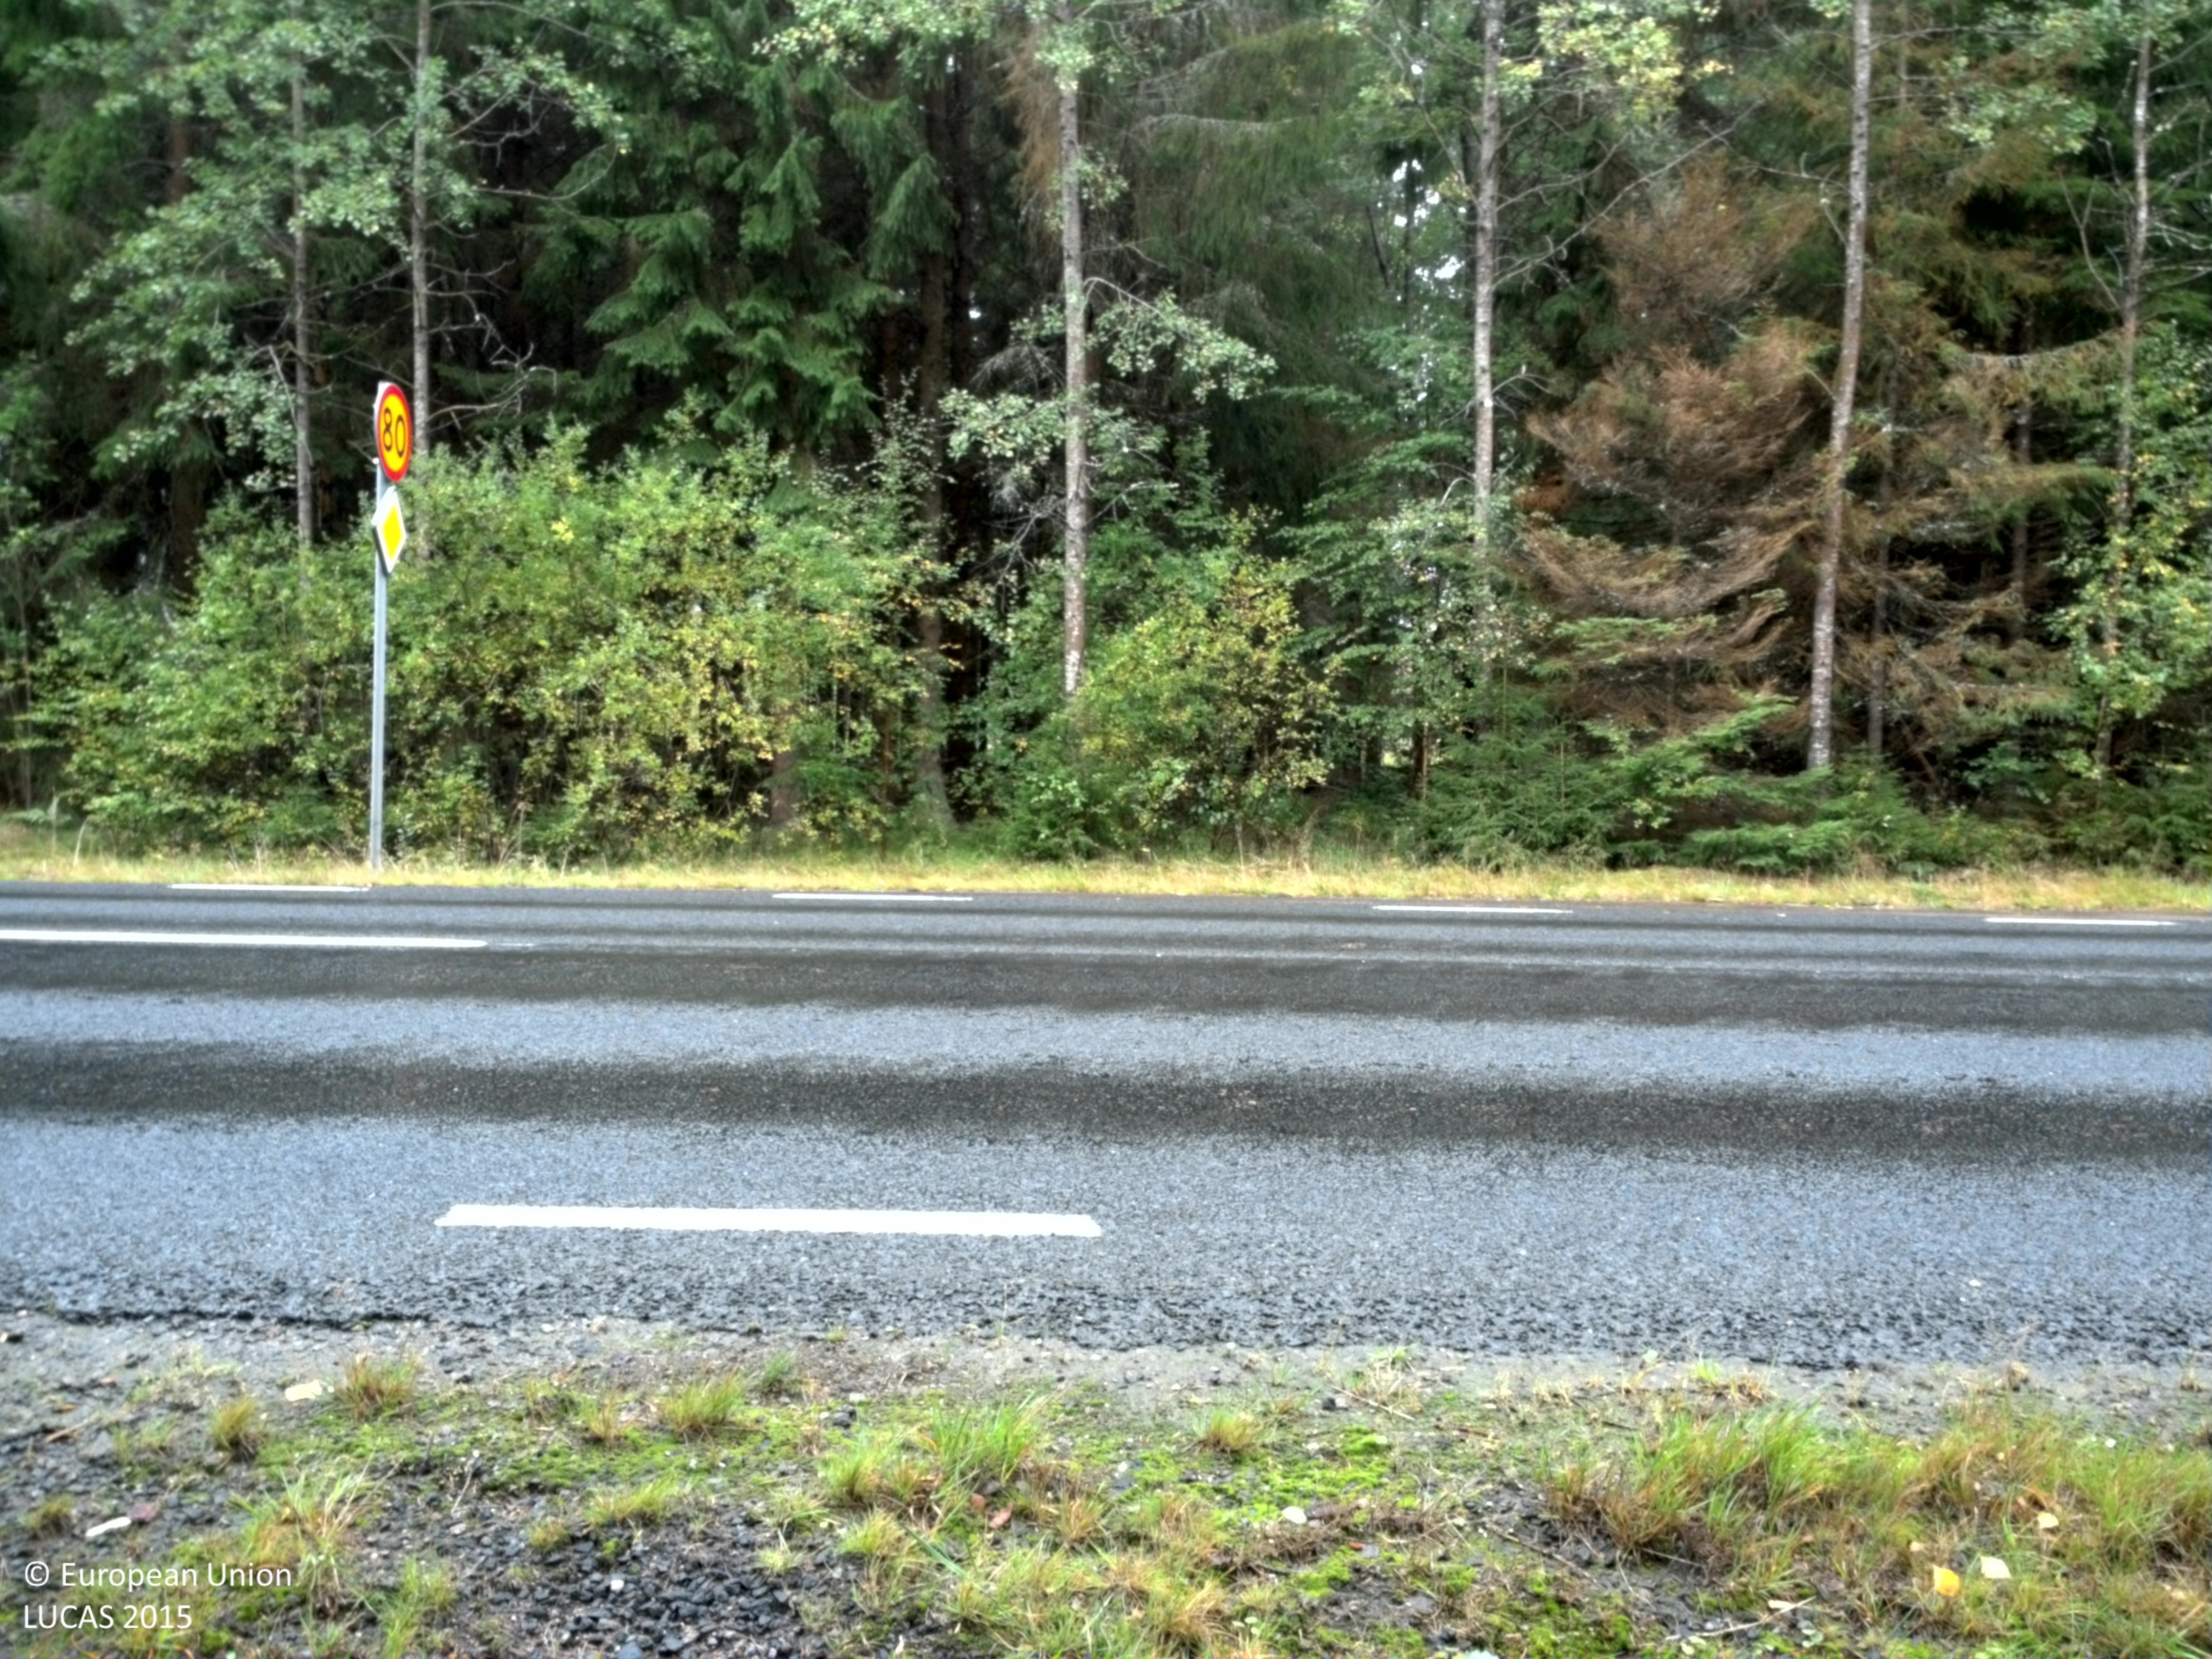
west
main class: Woodland
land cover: Spruce dominated mixed woodland
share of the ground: 50 - 75 %
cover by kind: coniferous forest trees 45 %, herbaceous plants 35 %, broadleaved forest trees 20 %
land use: Forestry
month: September
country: SE
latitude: 58.9503
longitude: 14.0774
